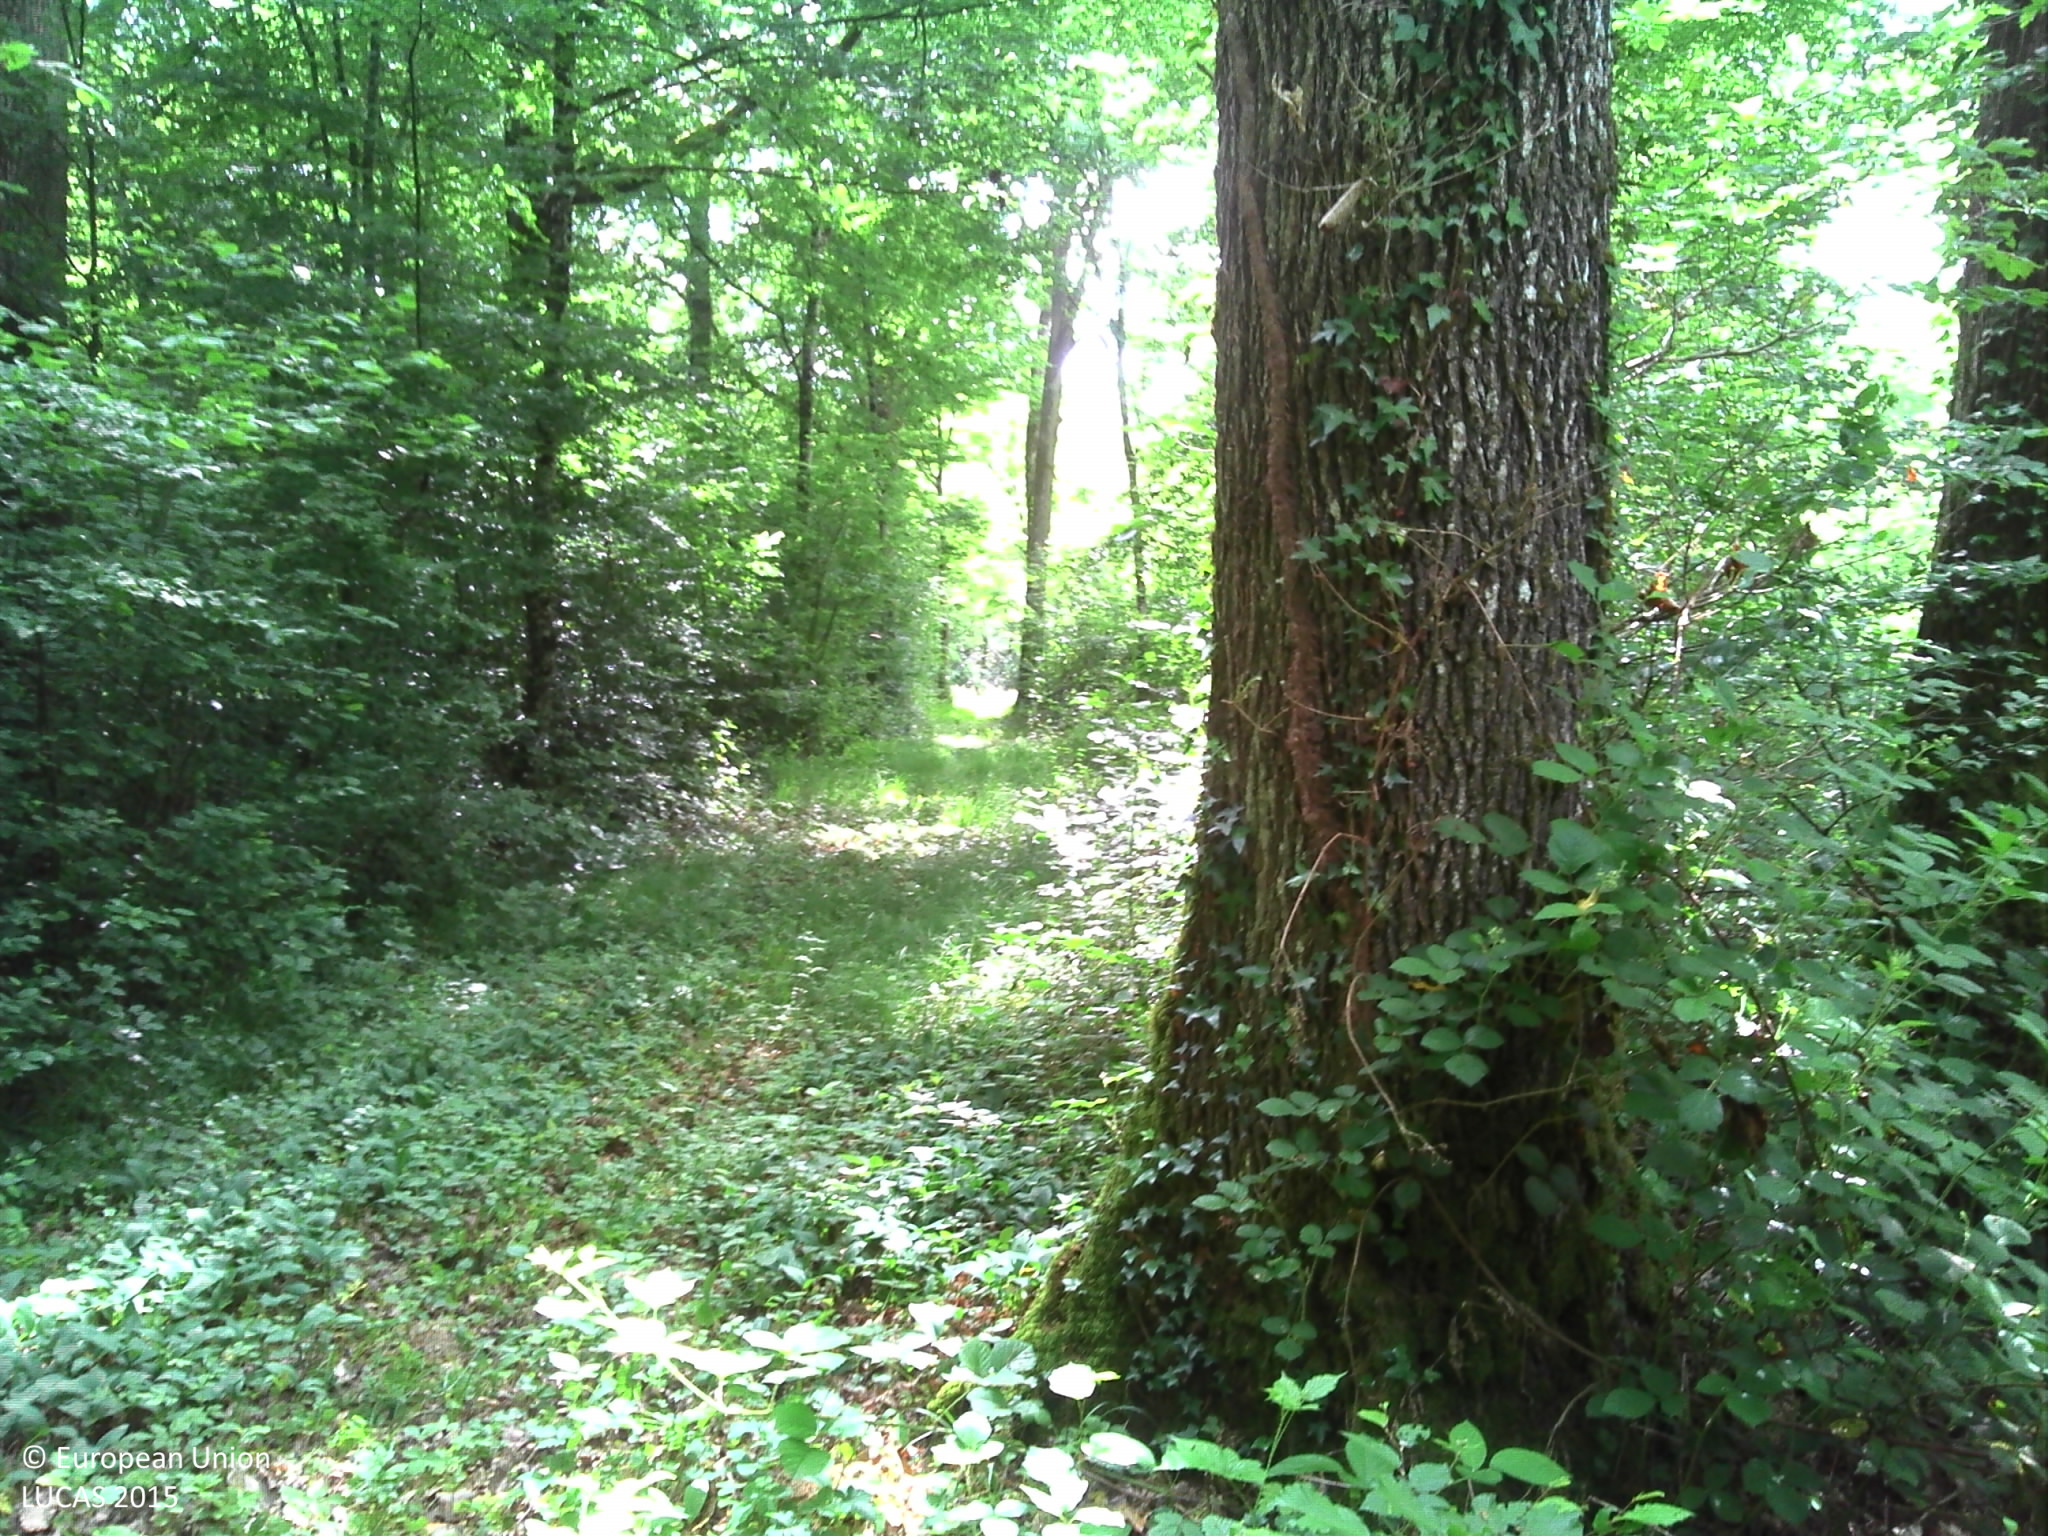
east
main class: Woodland
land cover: Broadleaved woodland
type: mesophytic deciduous forest
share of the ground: > 75 %
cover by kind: broadleaved forest trees 90 %, herbaceous plants 10 %
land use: Forestry
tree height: > 5 m
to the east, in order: Broadleaved woodland; Tracks; Broadleaved woodland; Grassland without tree/shrub cover; Paved roads, cycling and walking lanes; Grassland without tree/shrub cover; Broadleaved woodland; Ditches and canals; Tracks; Broadleaved woodland; Tracks; Broadleaved woodland
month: May
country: FR
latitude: 47.2393
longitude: 5.2850
